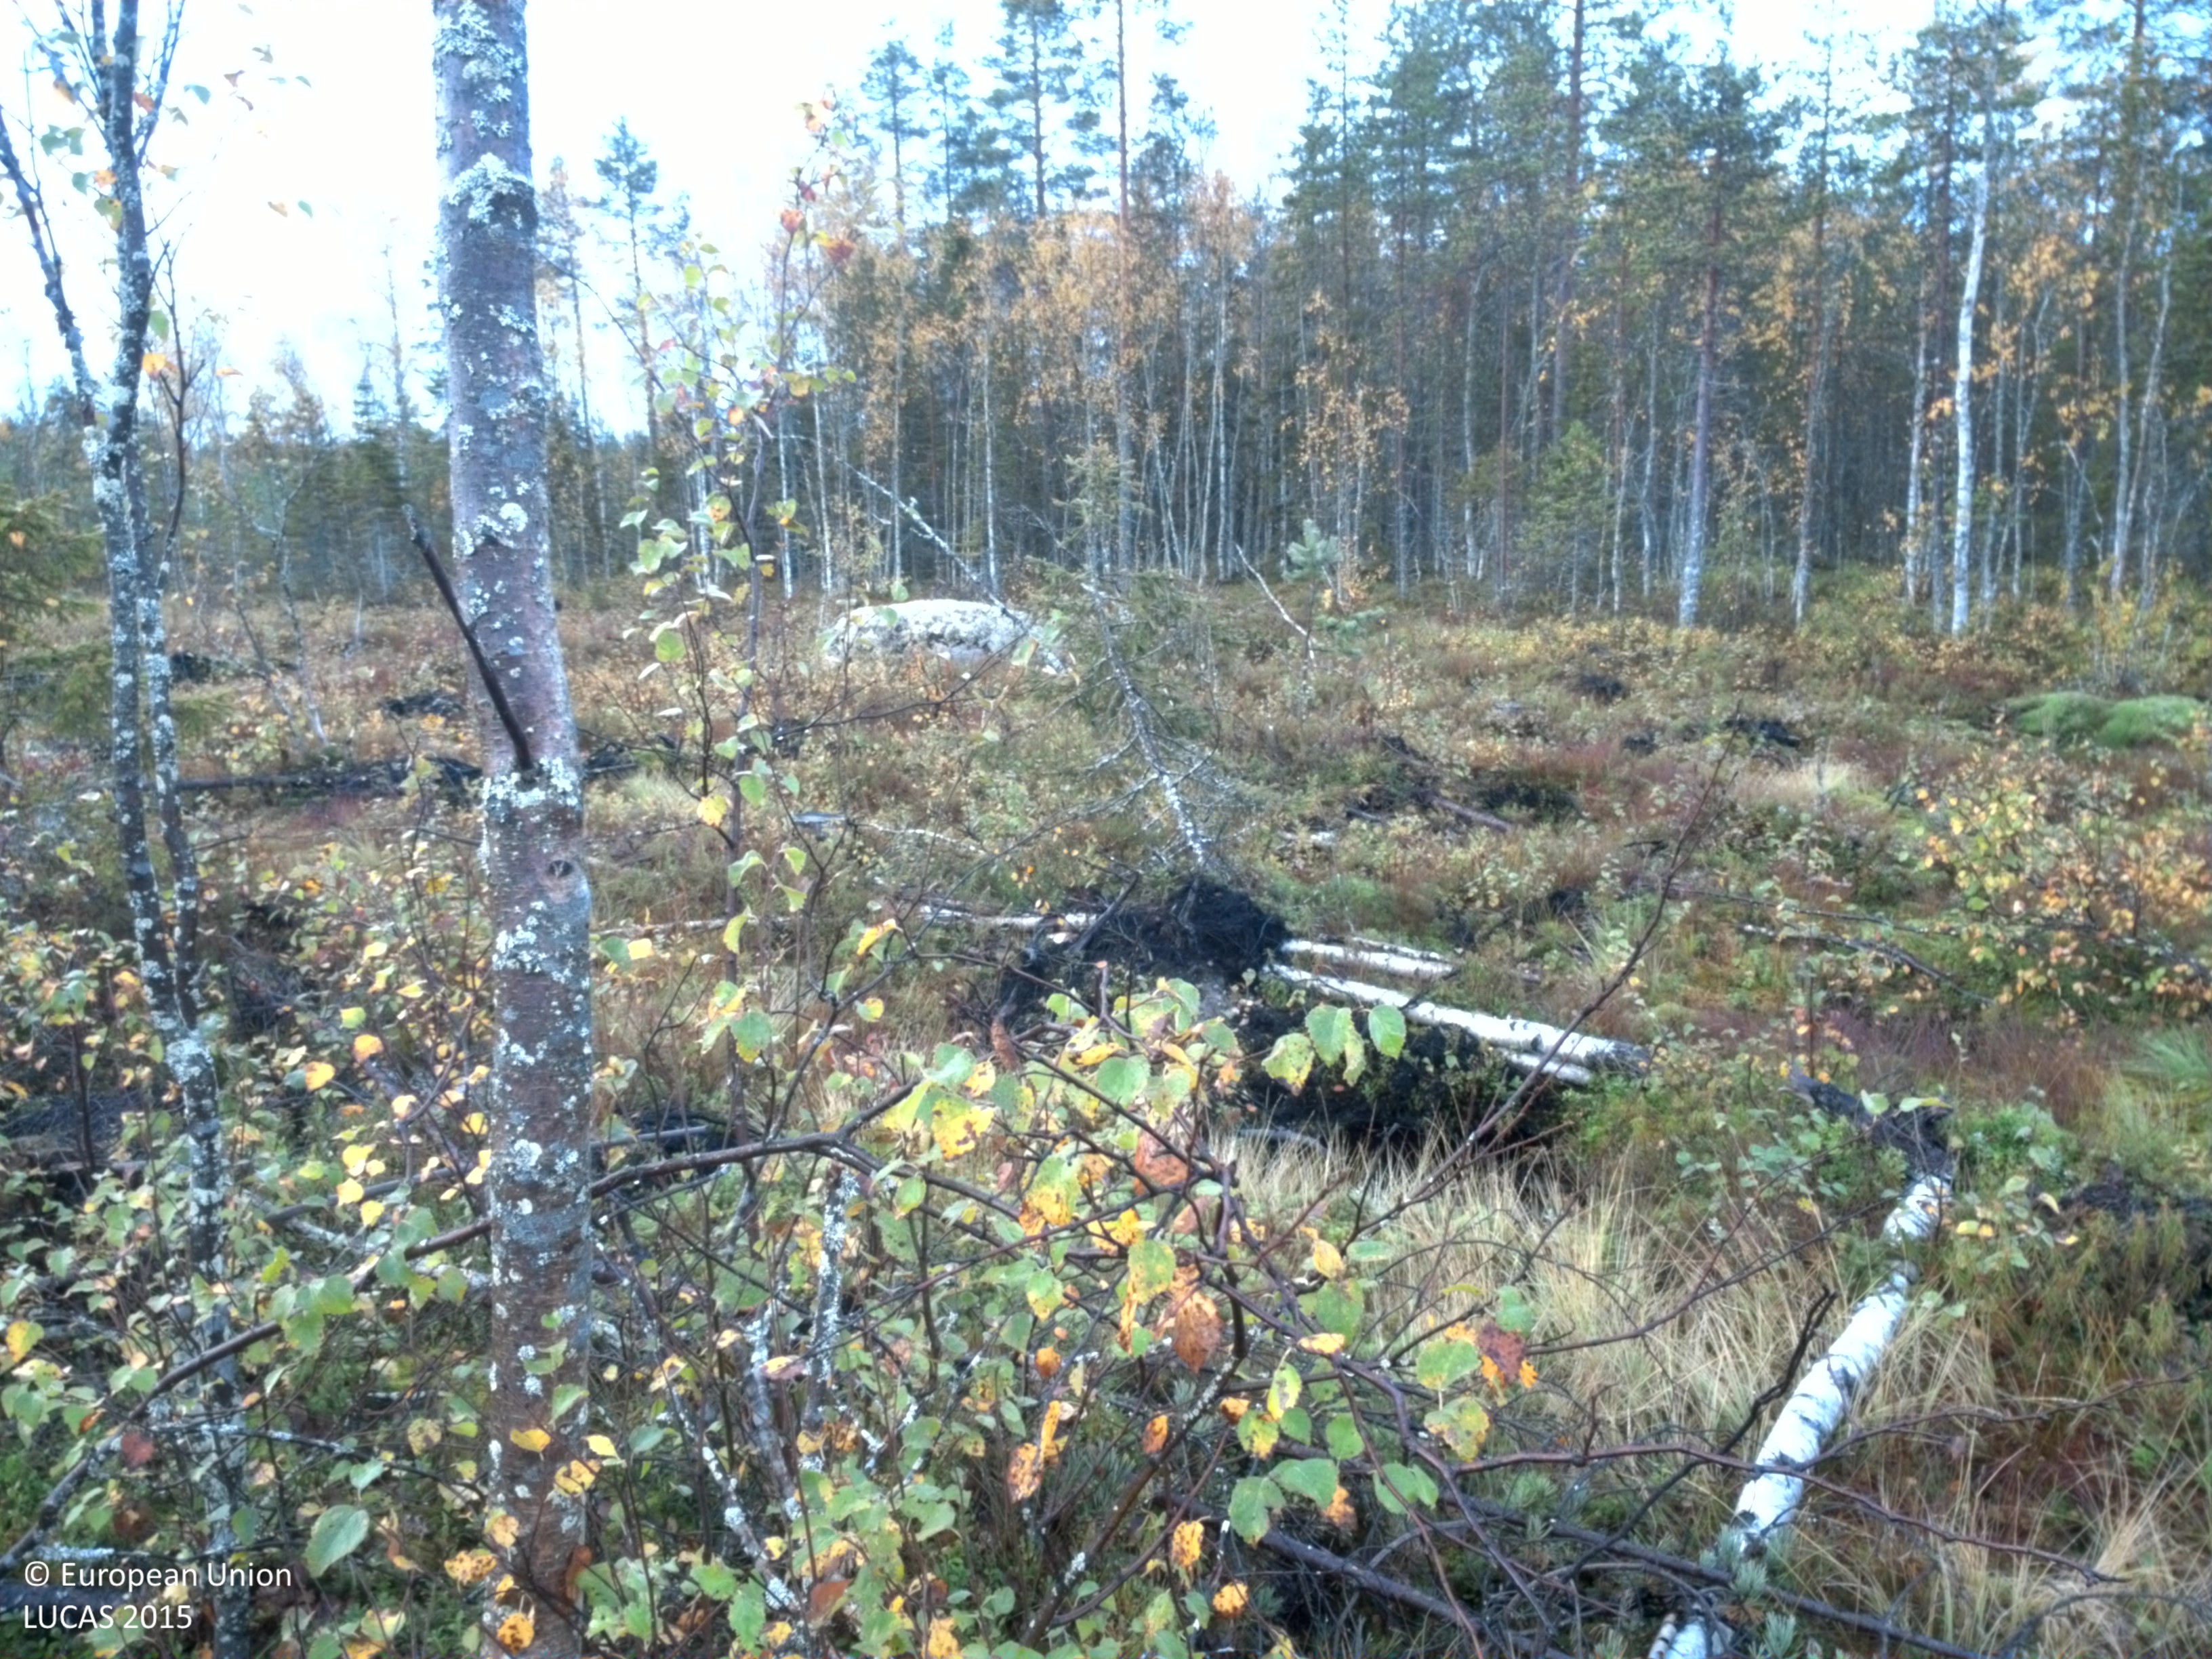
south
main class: Shrubland
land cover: Shrubland with sparse tree cover
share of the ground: 25 - 50 %
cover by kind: herbaceous plants 45 %, shrubs 40 %, lichens and mosses 10 %, broadleaved forest trees 5 %
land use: Forestry
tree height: < 5 m
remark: Clear cut
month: September
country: SE
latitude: 65.5807
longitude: 21.8782
